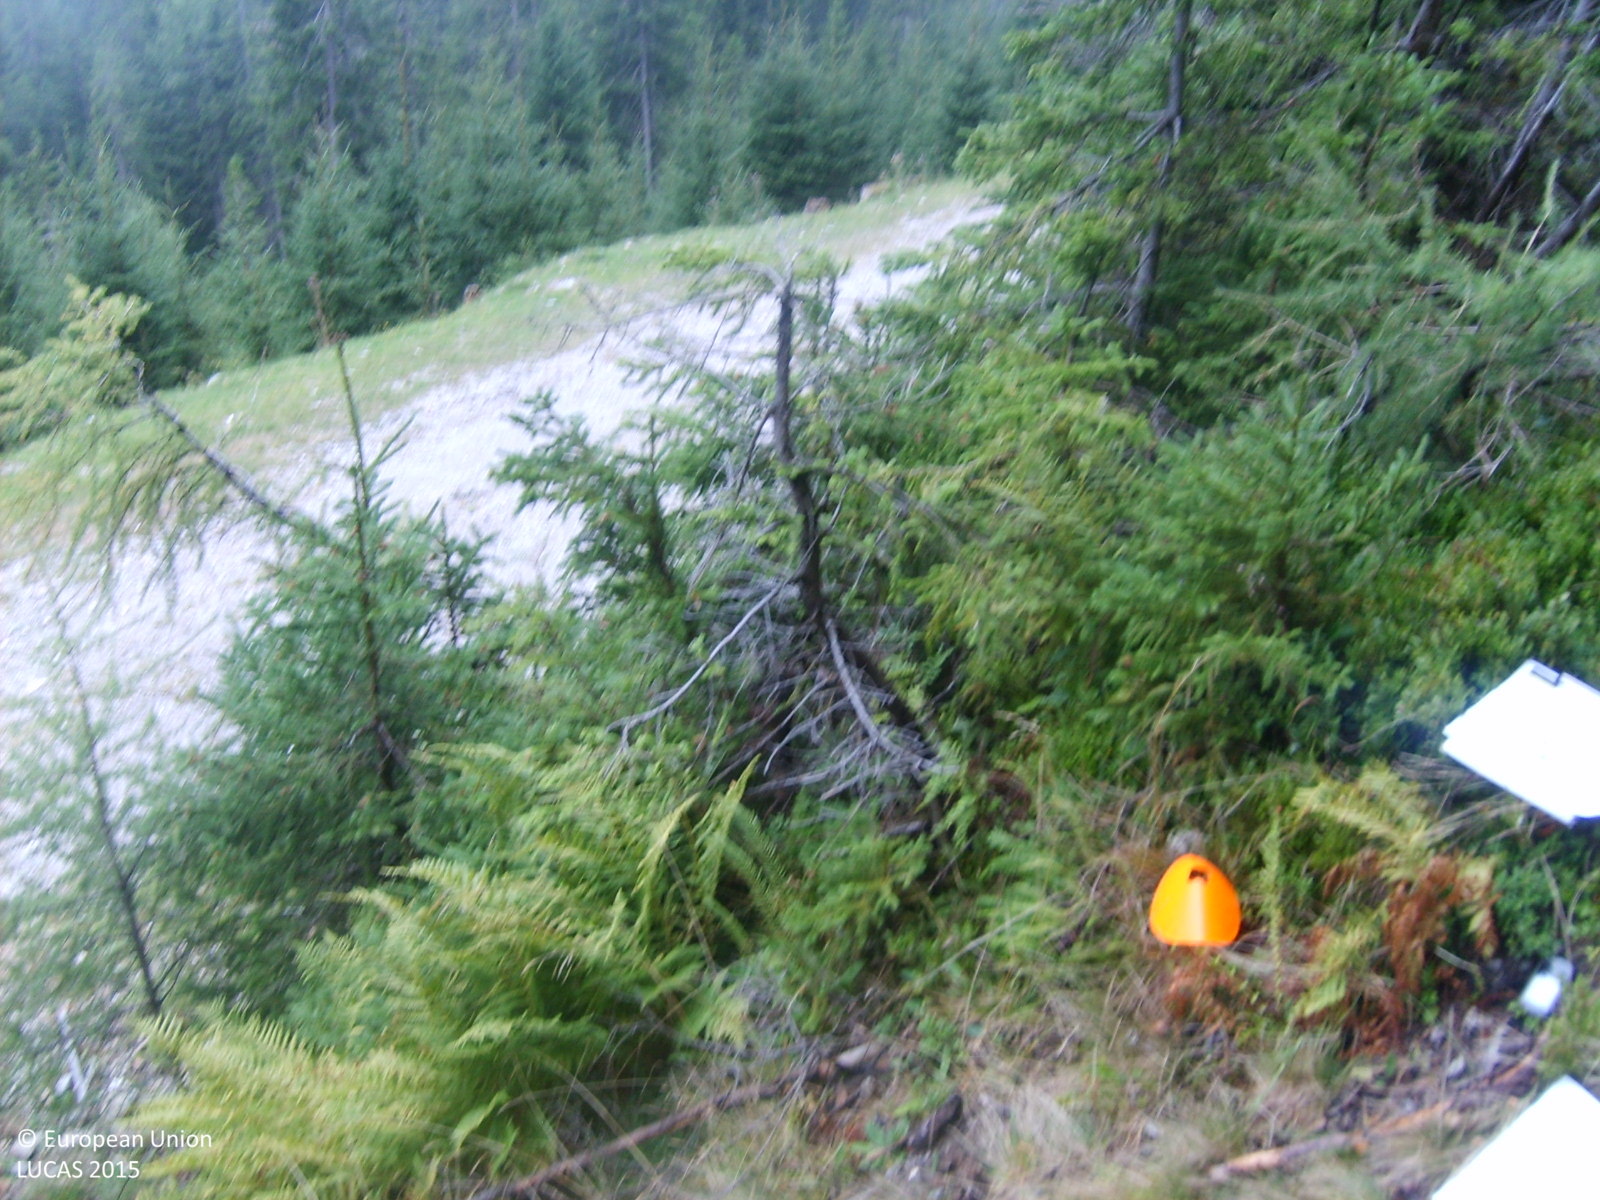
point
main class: Woodland
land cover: Spruce dominated coniferous woodland
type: alpine coniferous forest
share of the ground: > 75 %
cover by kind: coniferous forest trees 85 %, shrubs 10 %, herbaceous plants 5 %
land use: Forestry
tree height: > 5 m
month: September
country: AT
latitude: 47.4111
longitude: 13.5103
